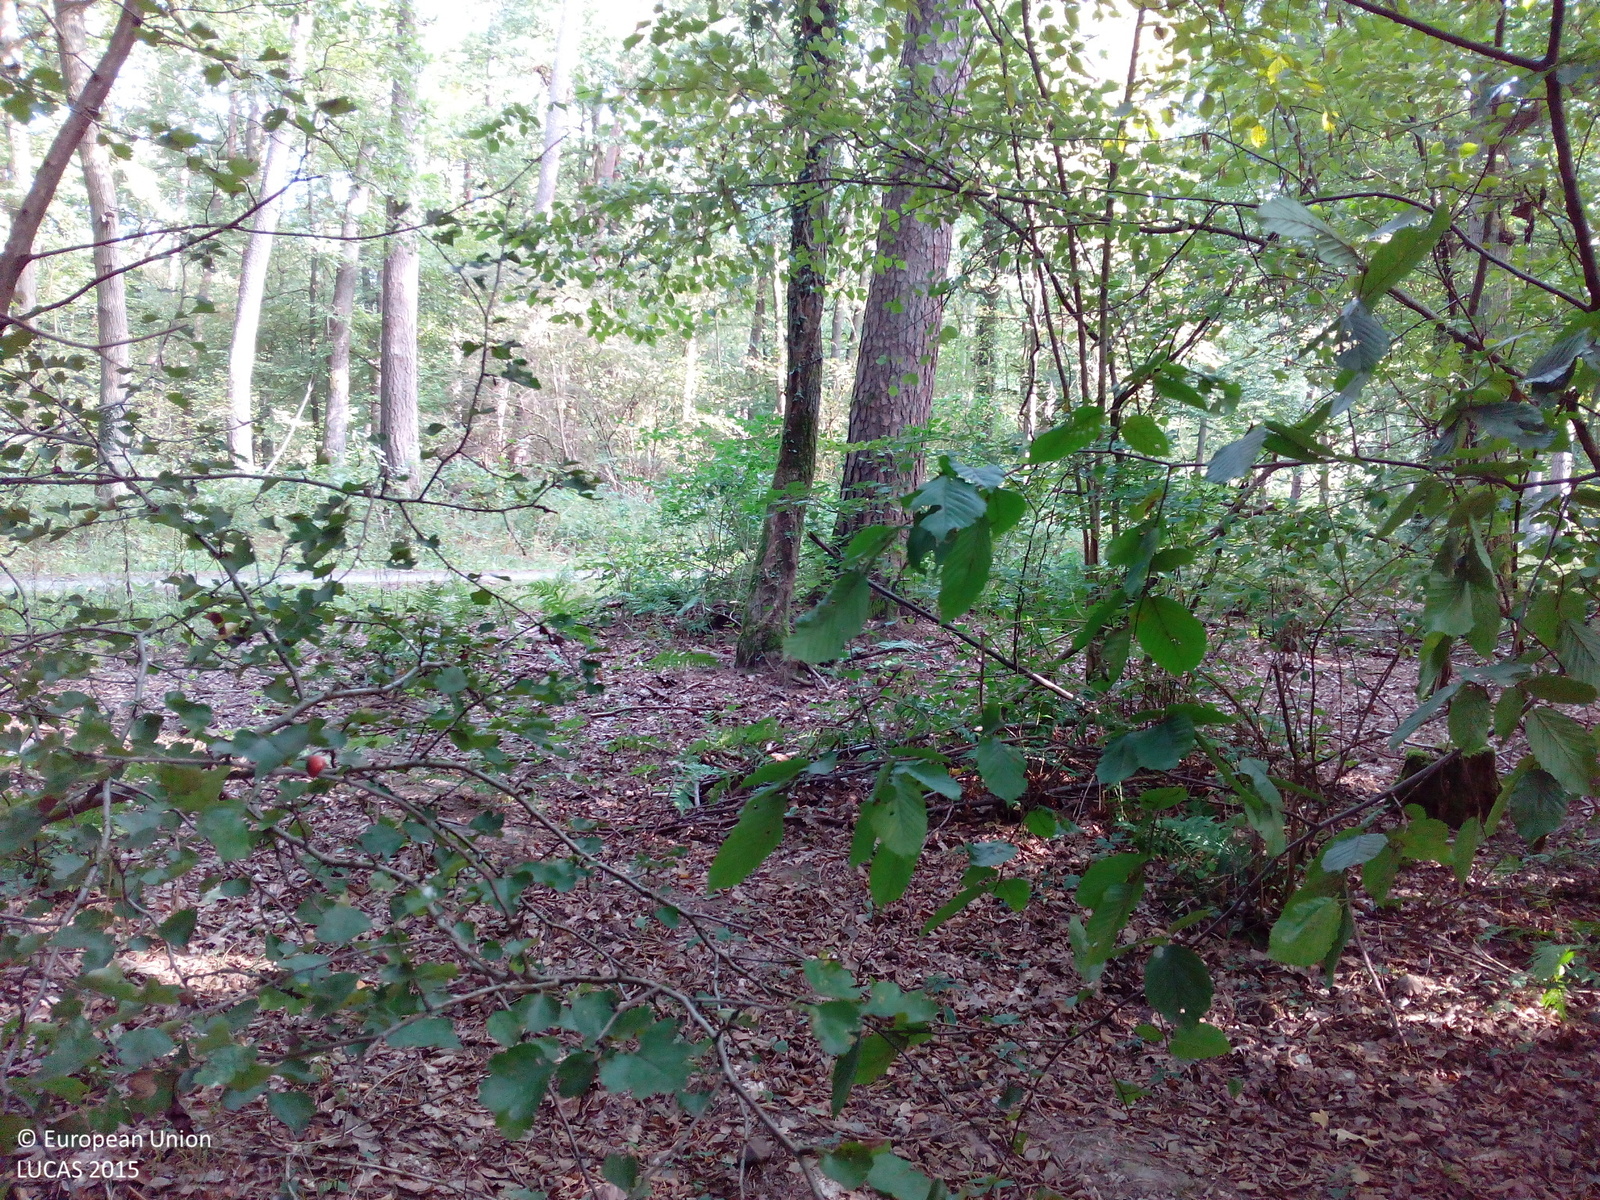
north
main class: Woodland
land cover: Pine dominated mixed woodland
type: hemiboreal forest and nemoral coniferous forest and mixed broadleaved-coniferous forest
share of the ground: > 75 %
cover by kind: broadleaved forest trees 55 %, coniferous forest trees 40 %, herbaceous plants 5 %
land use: Forestry
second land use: Amenities, museums, leisure
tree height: > 5 m
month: September
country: DE
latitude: 49.7878
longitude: 9.5696
